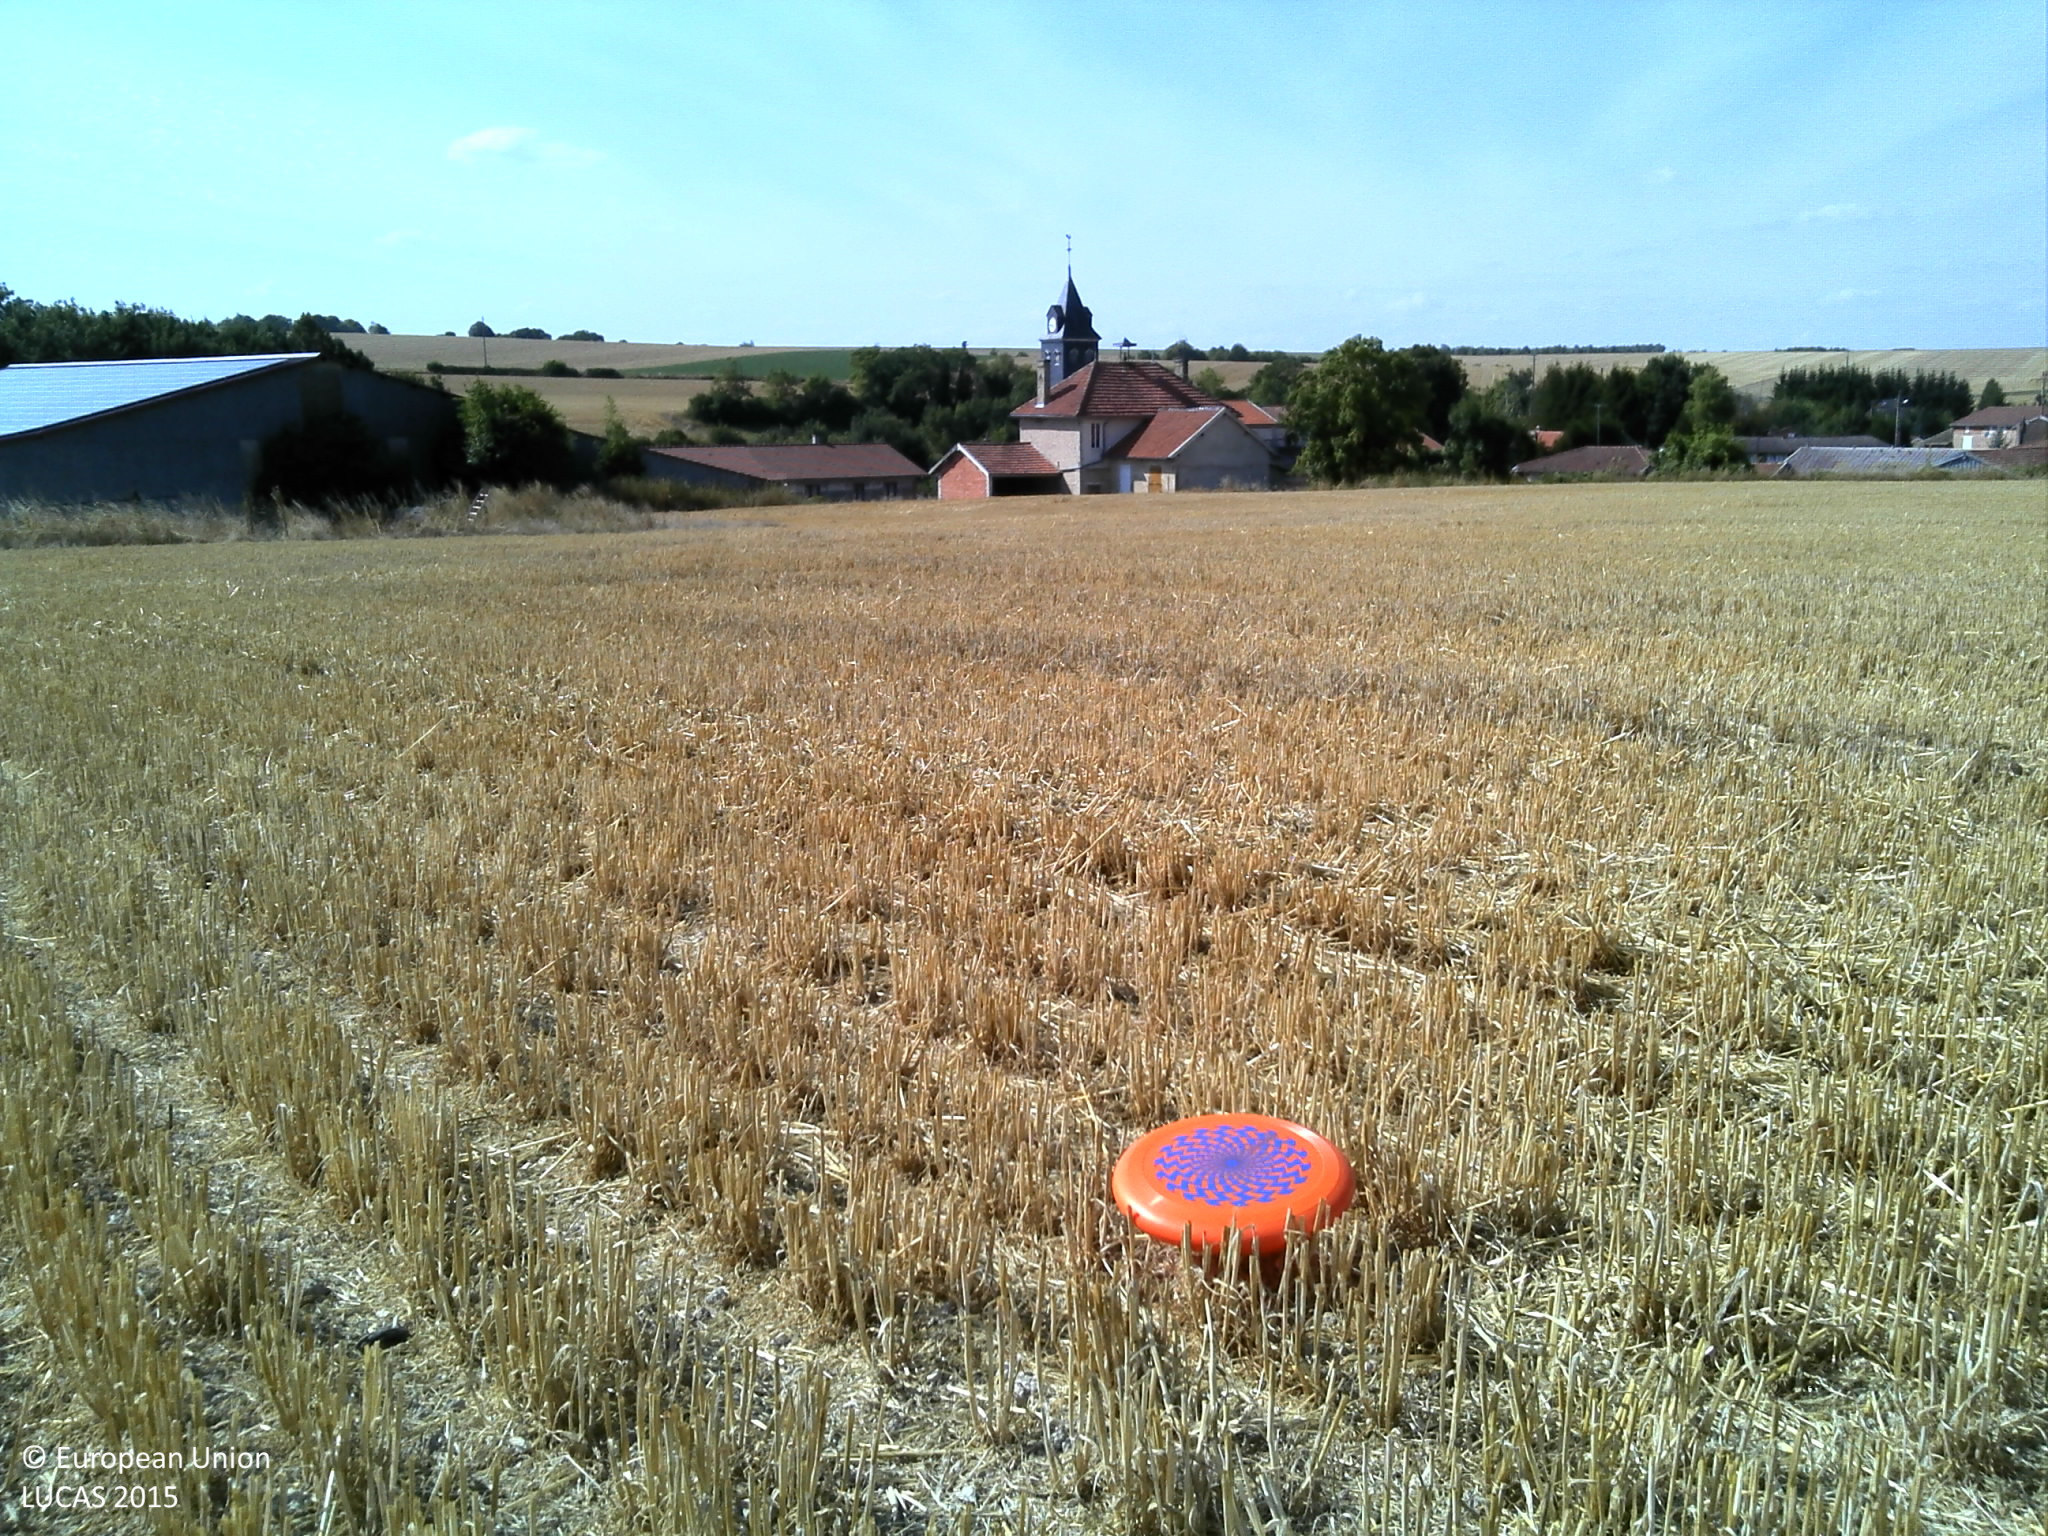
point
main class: Cropland
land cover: Barley
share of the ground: > 75 %
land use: Agriculture (excluding fallow land and kitchen gardens)
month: August
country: FR
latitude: 48.9236
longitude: 4.6608
